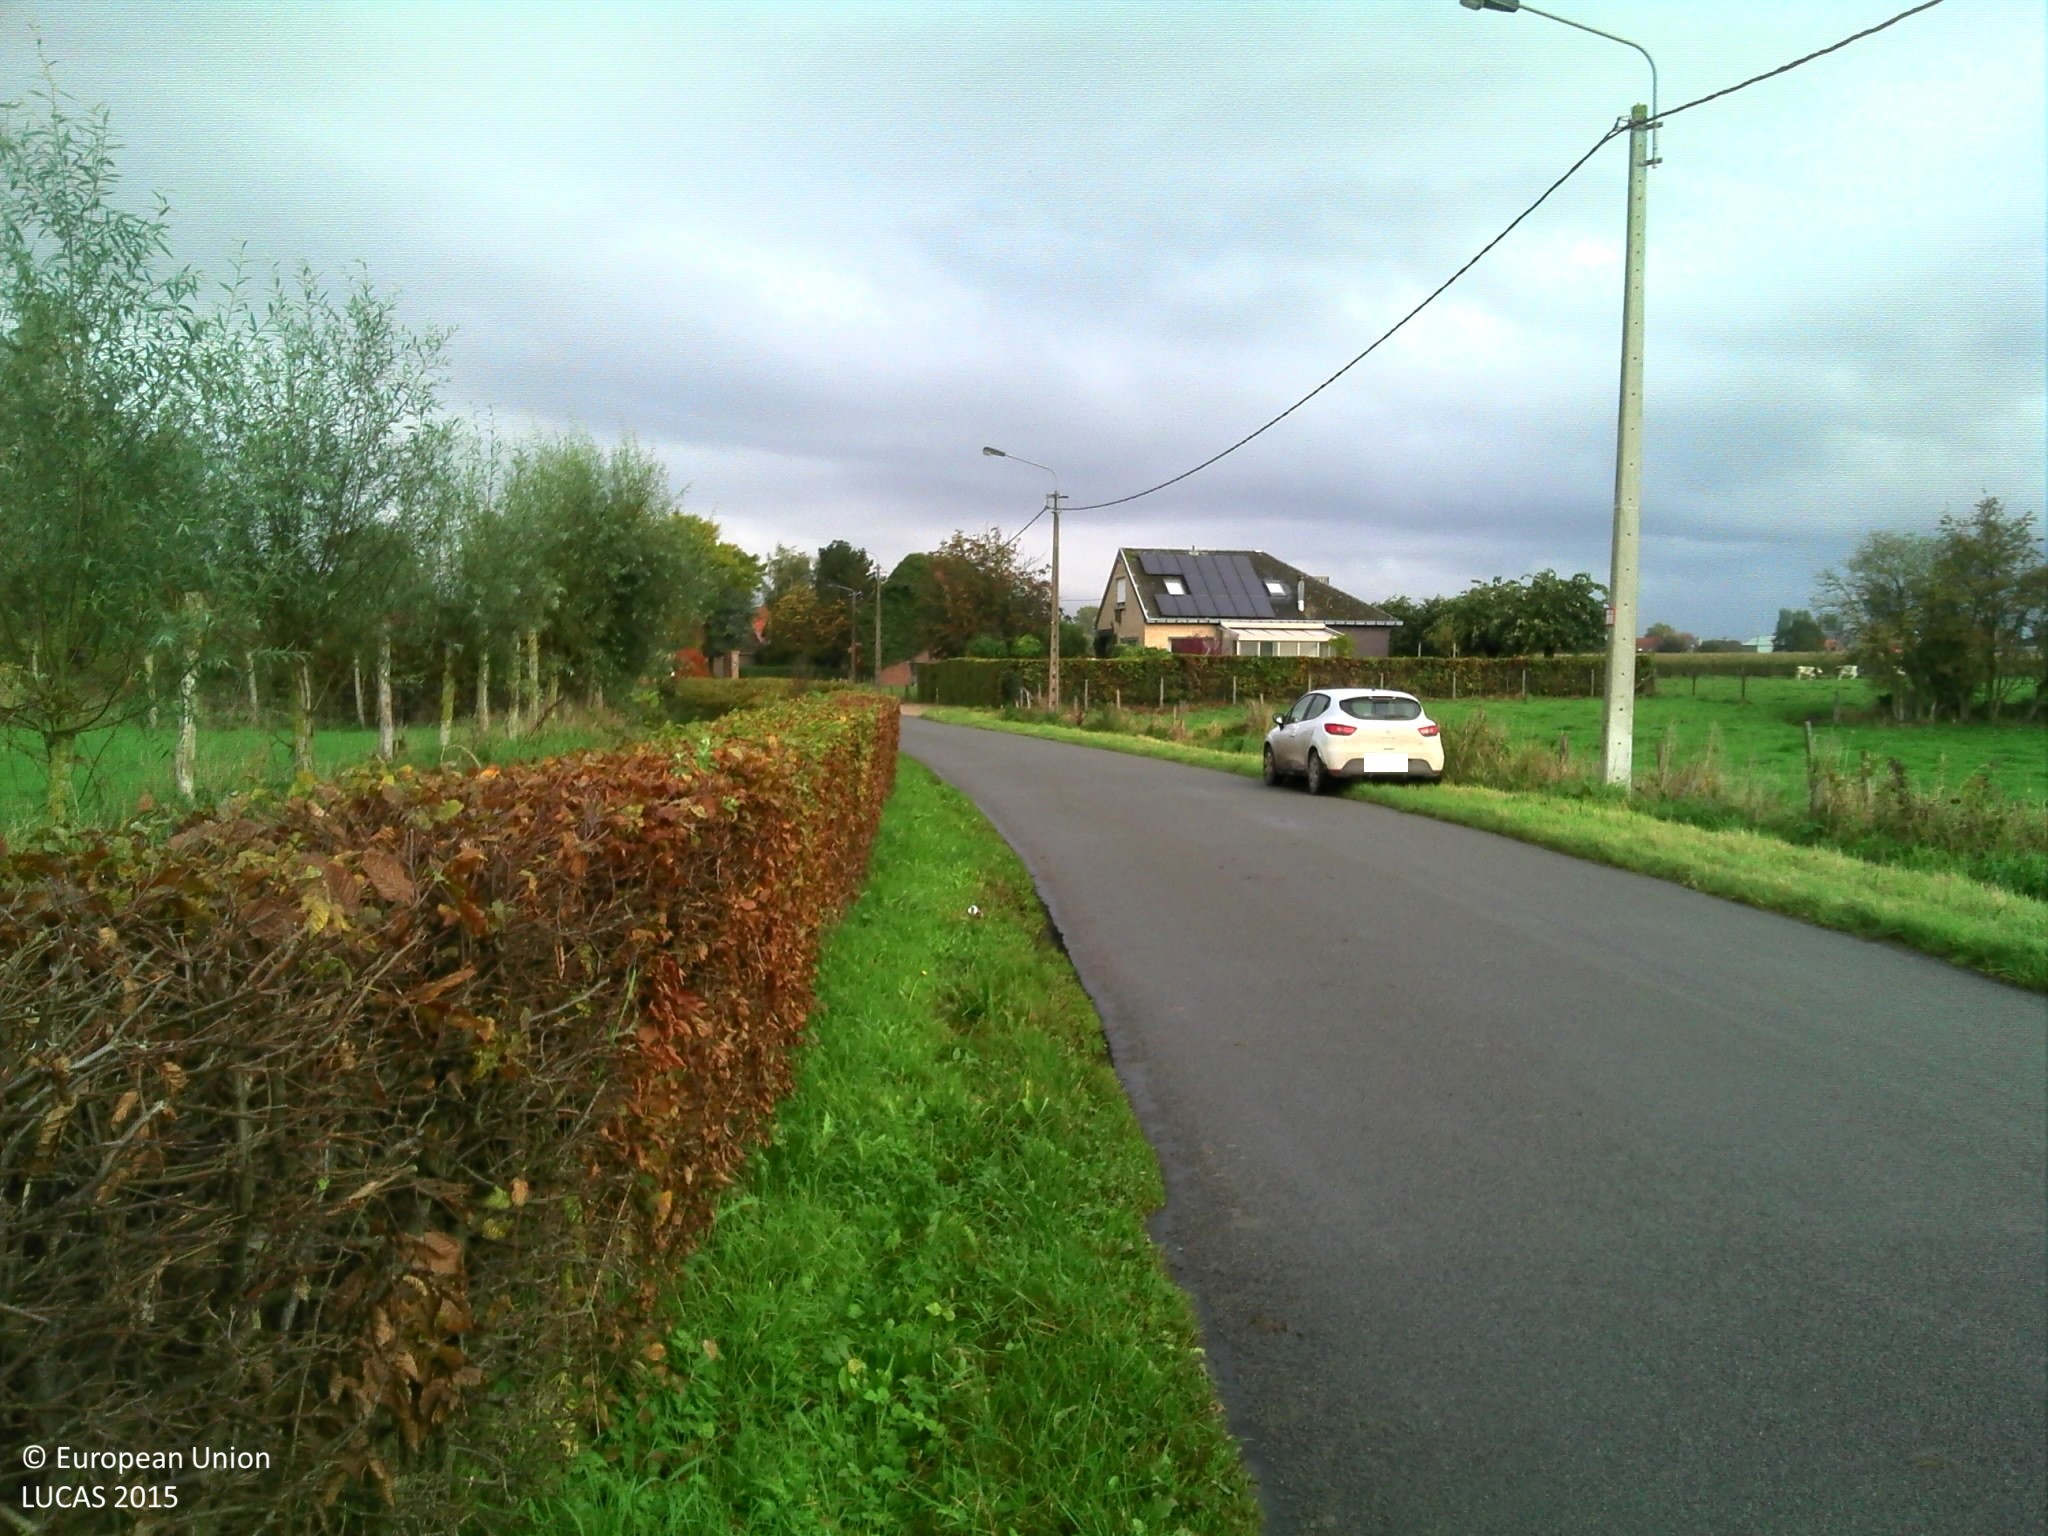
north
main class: Grassland
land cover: Grassland without tree/shrub cover
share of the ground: > 75 %
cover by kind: herbaceous plants 100 %
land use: Agriculture (excluding fallow land and kitchen gardens)
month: October
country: BE
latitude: 50.8890
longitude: 3.2957
